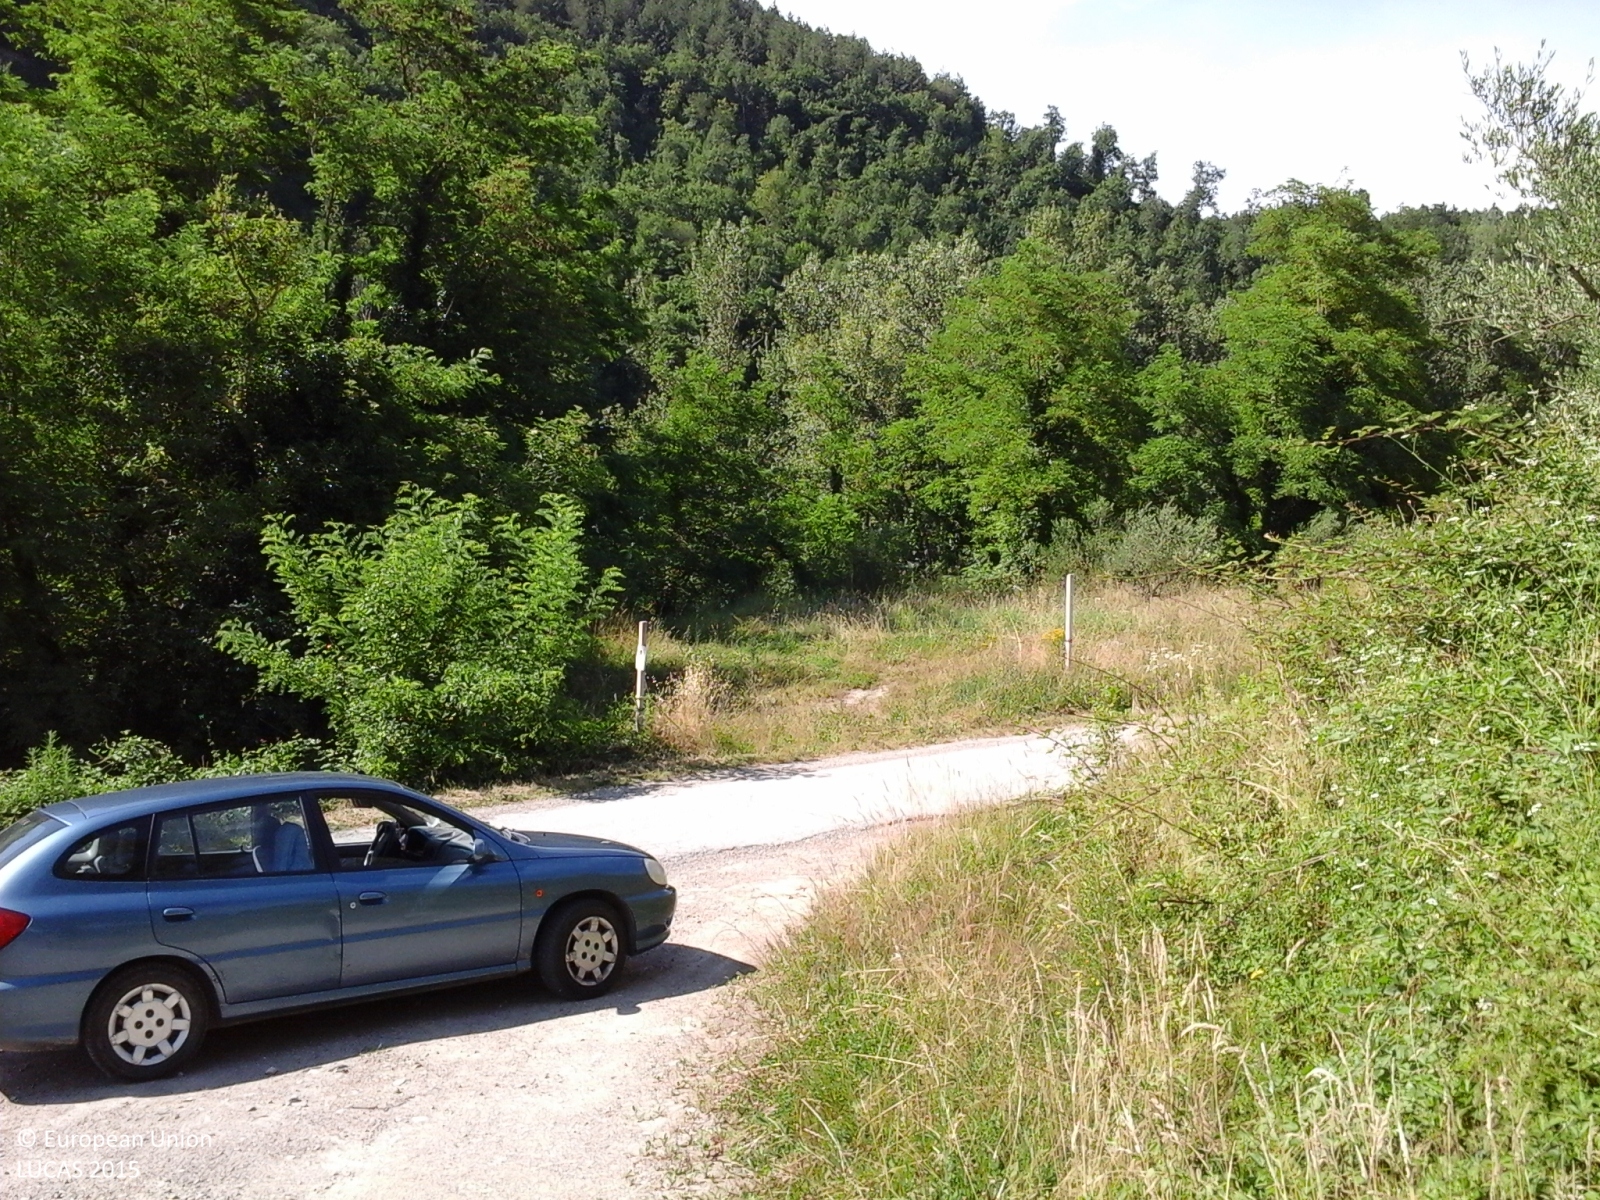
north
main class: Woodland
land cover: Pine dominated mixed woodland
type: coniferous forest of the mediterranean region
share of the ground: > 75 %
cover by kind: coniferous forest trees 60 %, broadleaved forest trees 40 %
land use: Forestry
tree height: > 5 m
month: June
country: IT
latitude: 44.2106
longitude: 11.6857
